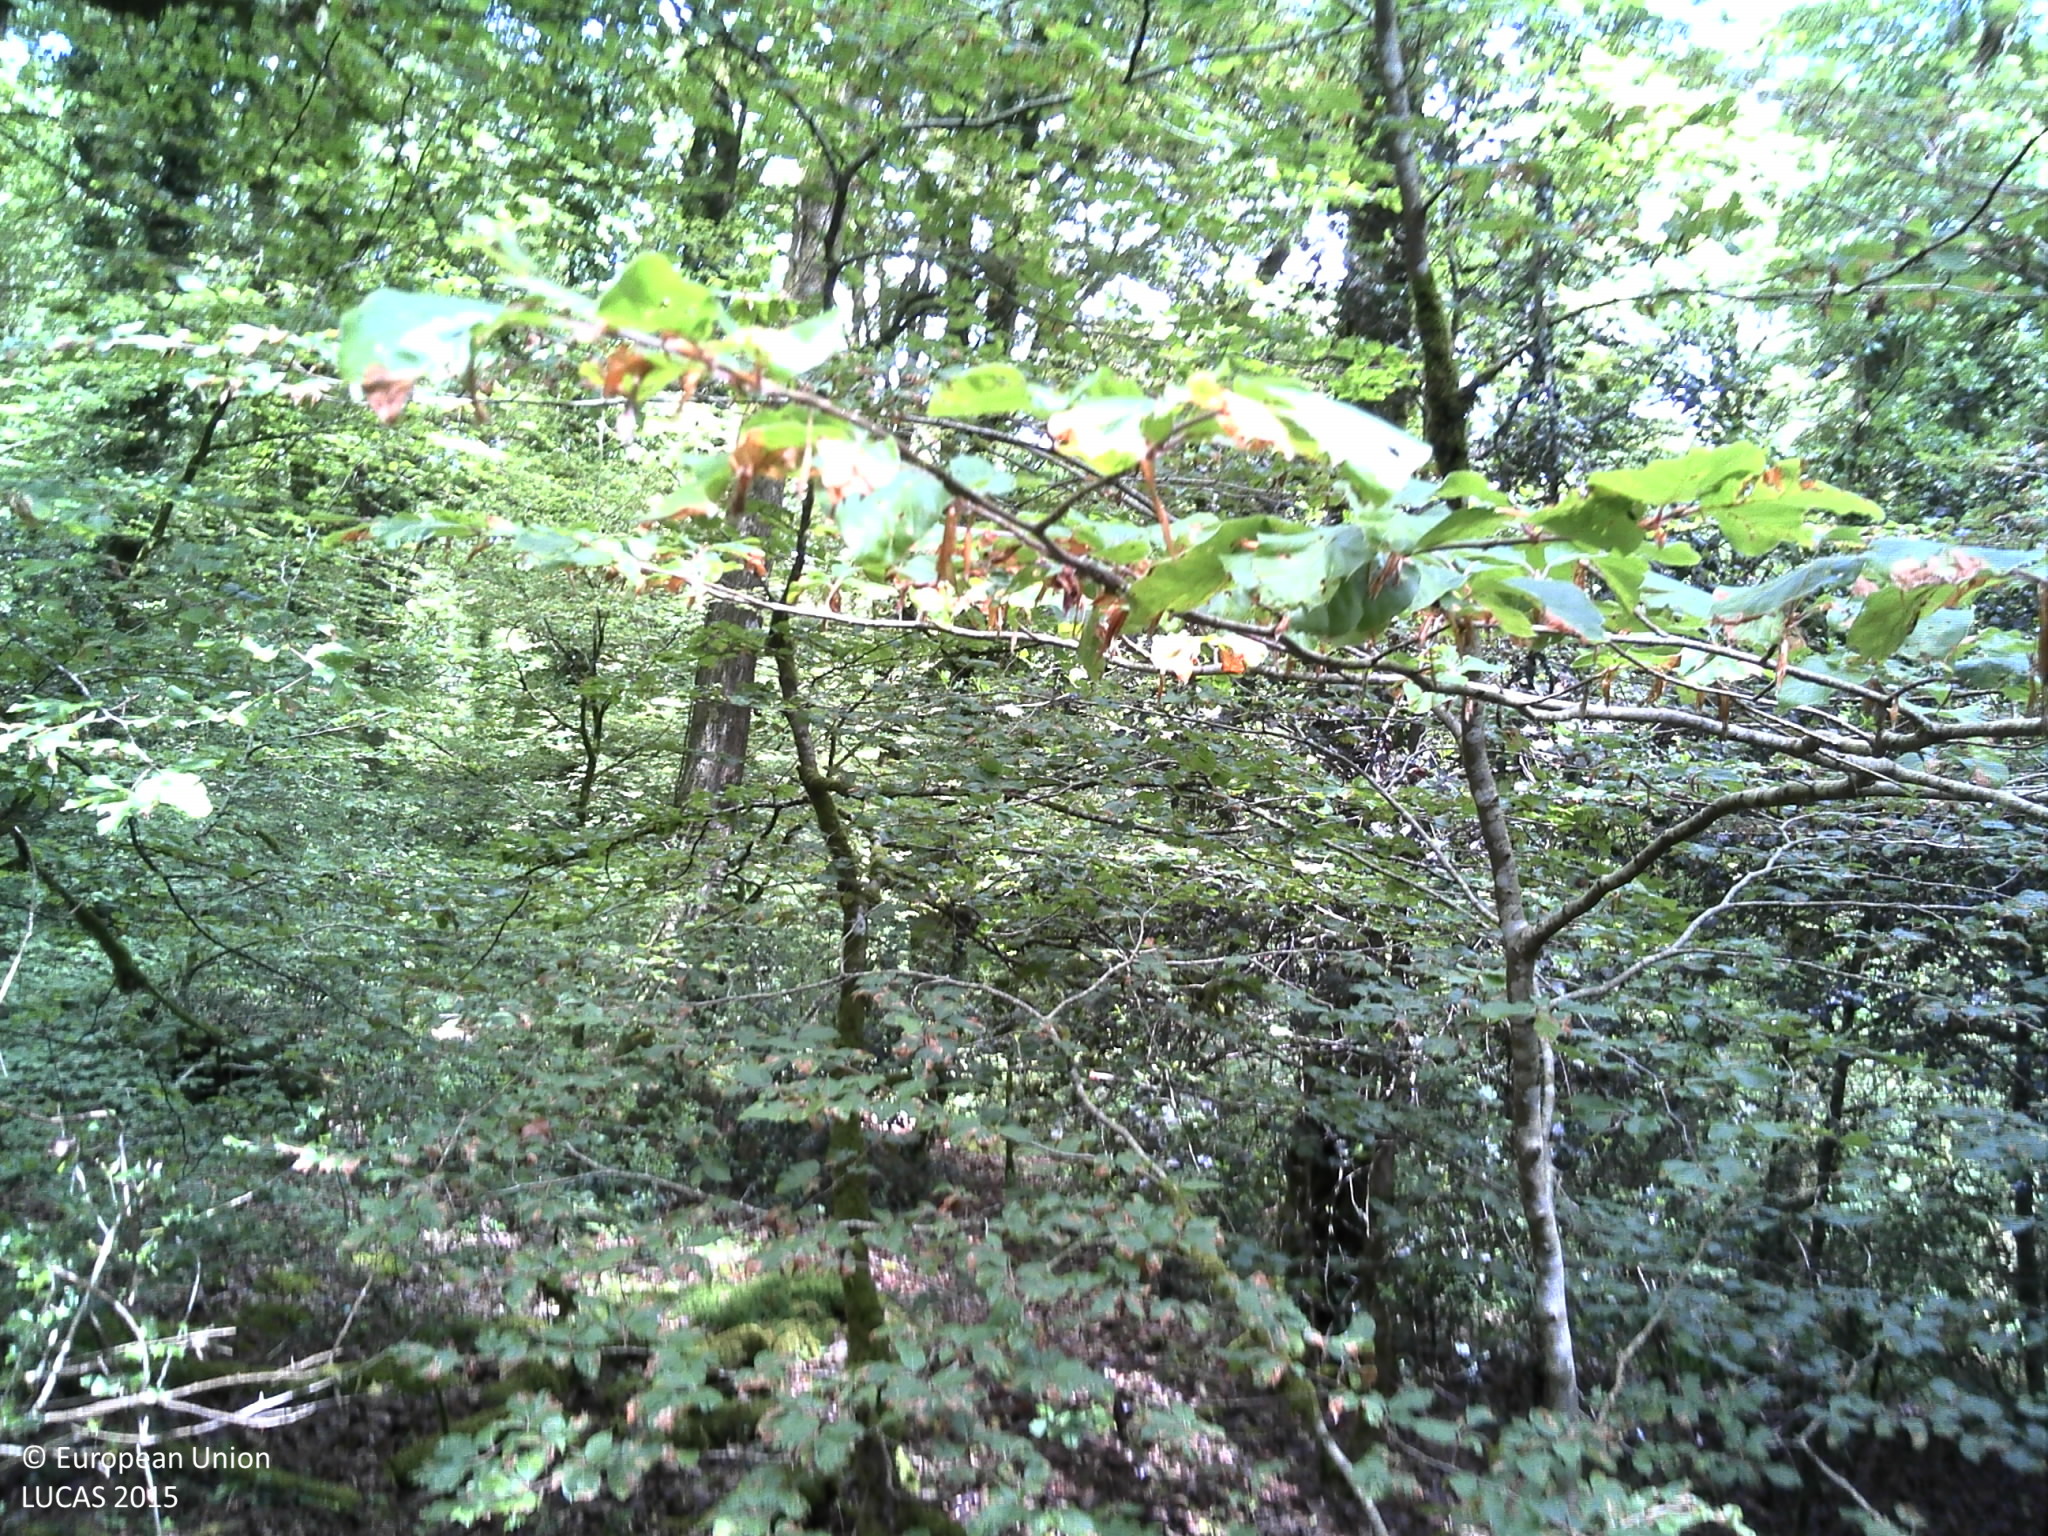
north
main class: Woodland
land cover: Broadleaved woodland
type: beech forest
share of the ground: > 75 %
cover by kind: broadleaved forest trees 95 %, herbaceous plants 5 %
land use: Forestry
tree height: > 5 m
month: June
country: FR
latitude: 47.8373
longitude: -3.5578
